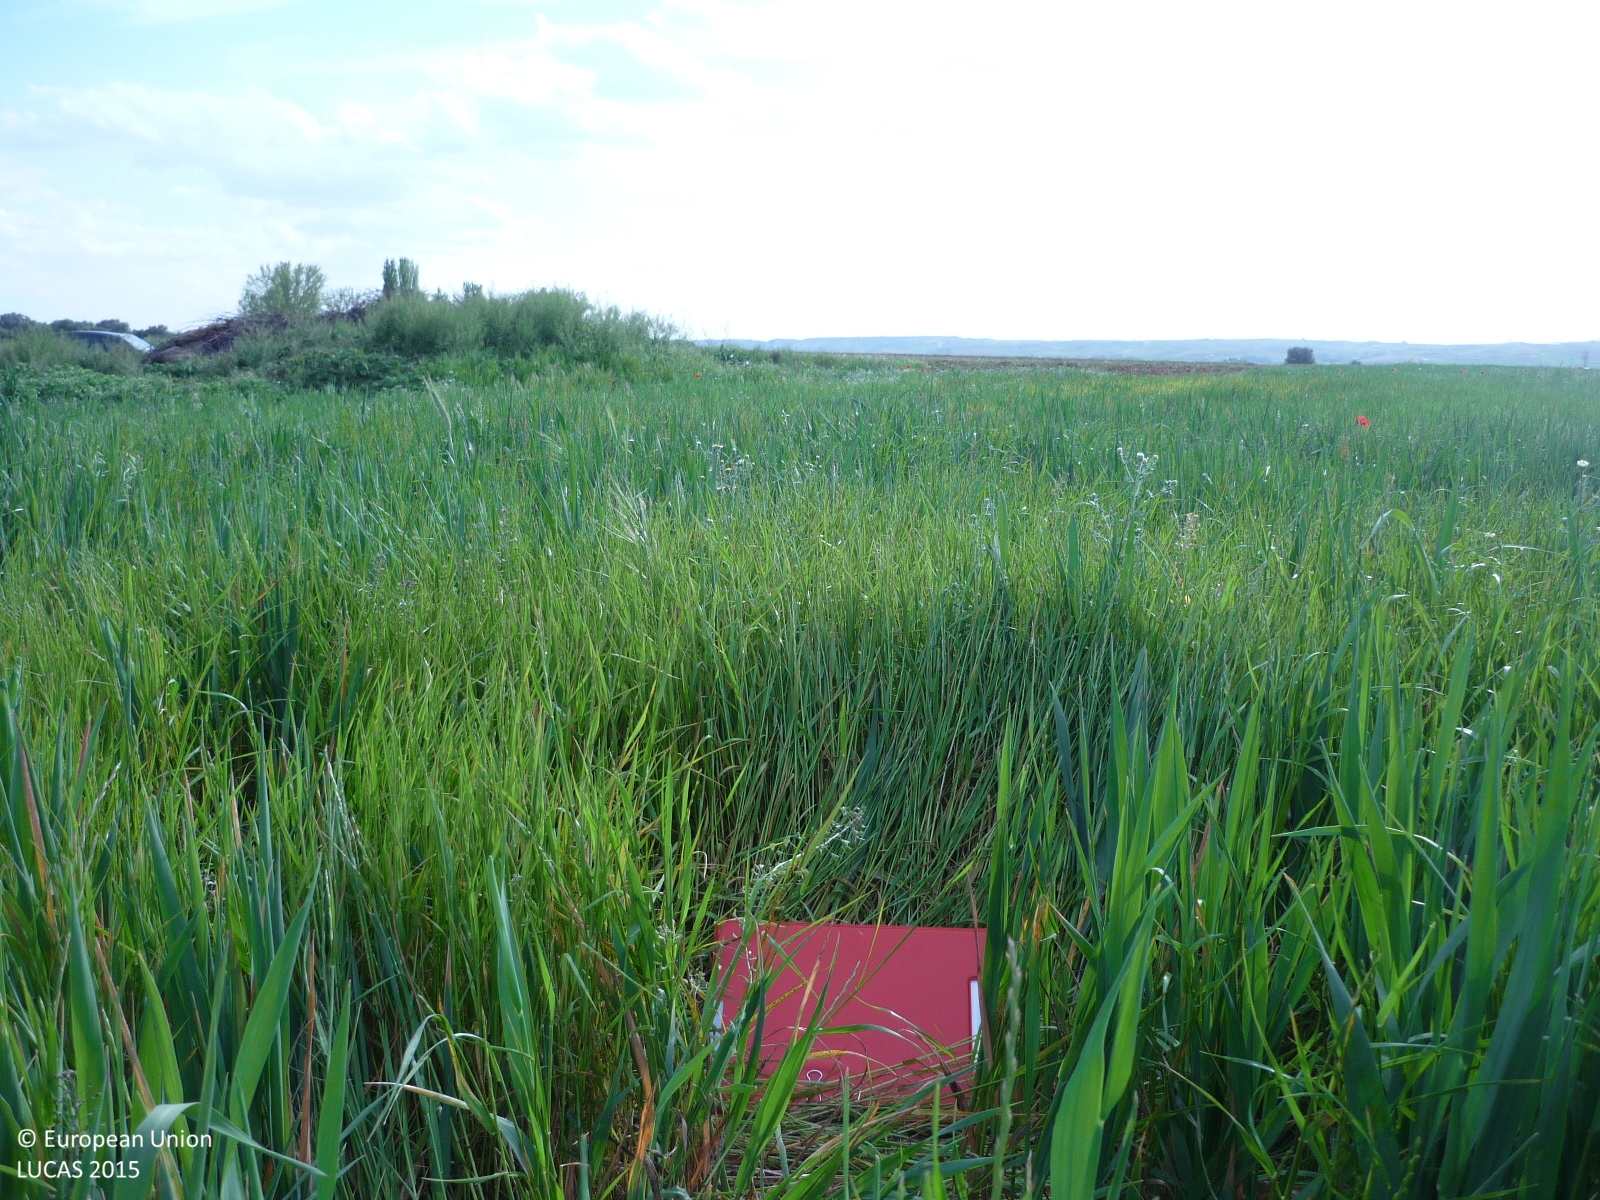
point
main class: Cropland
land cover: Oats
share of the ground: > 75 %
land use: Agriculture (excluding fallow land and kitchen gardens)
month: April
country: ES
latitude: 40.7390
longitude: -3.5032
